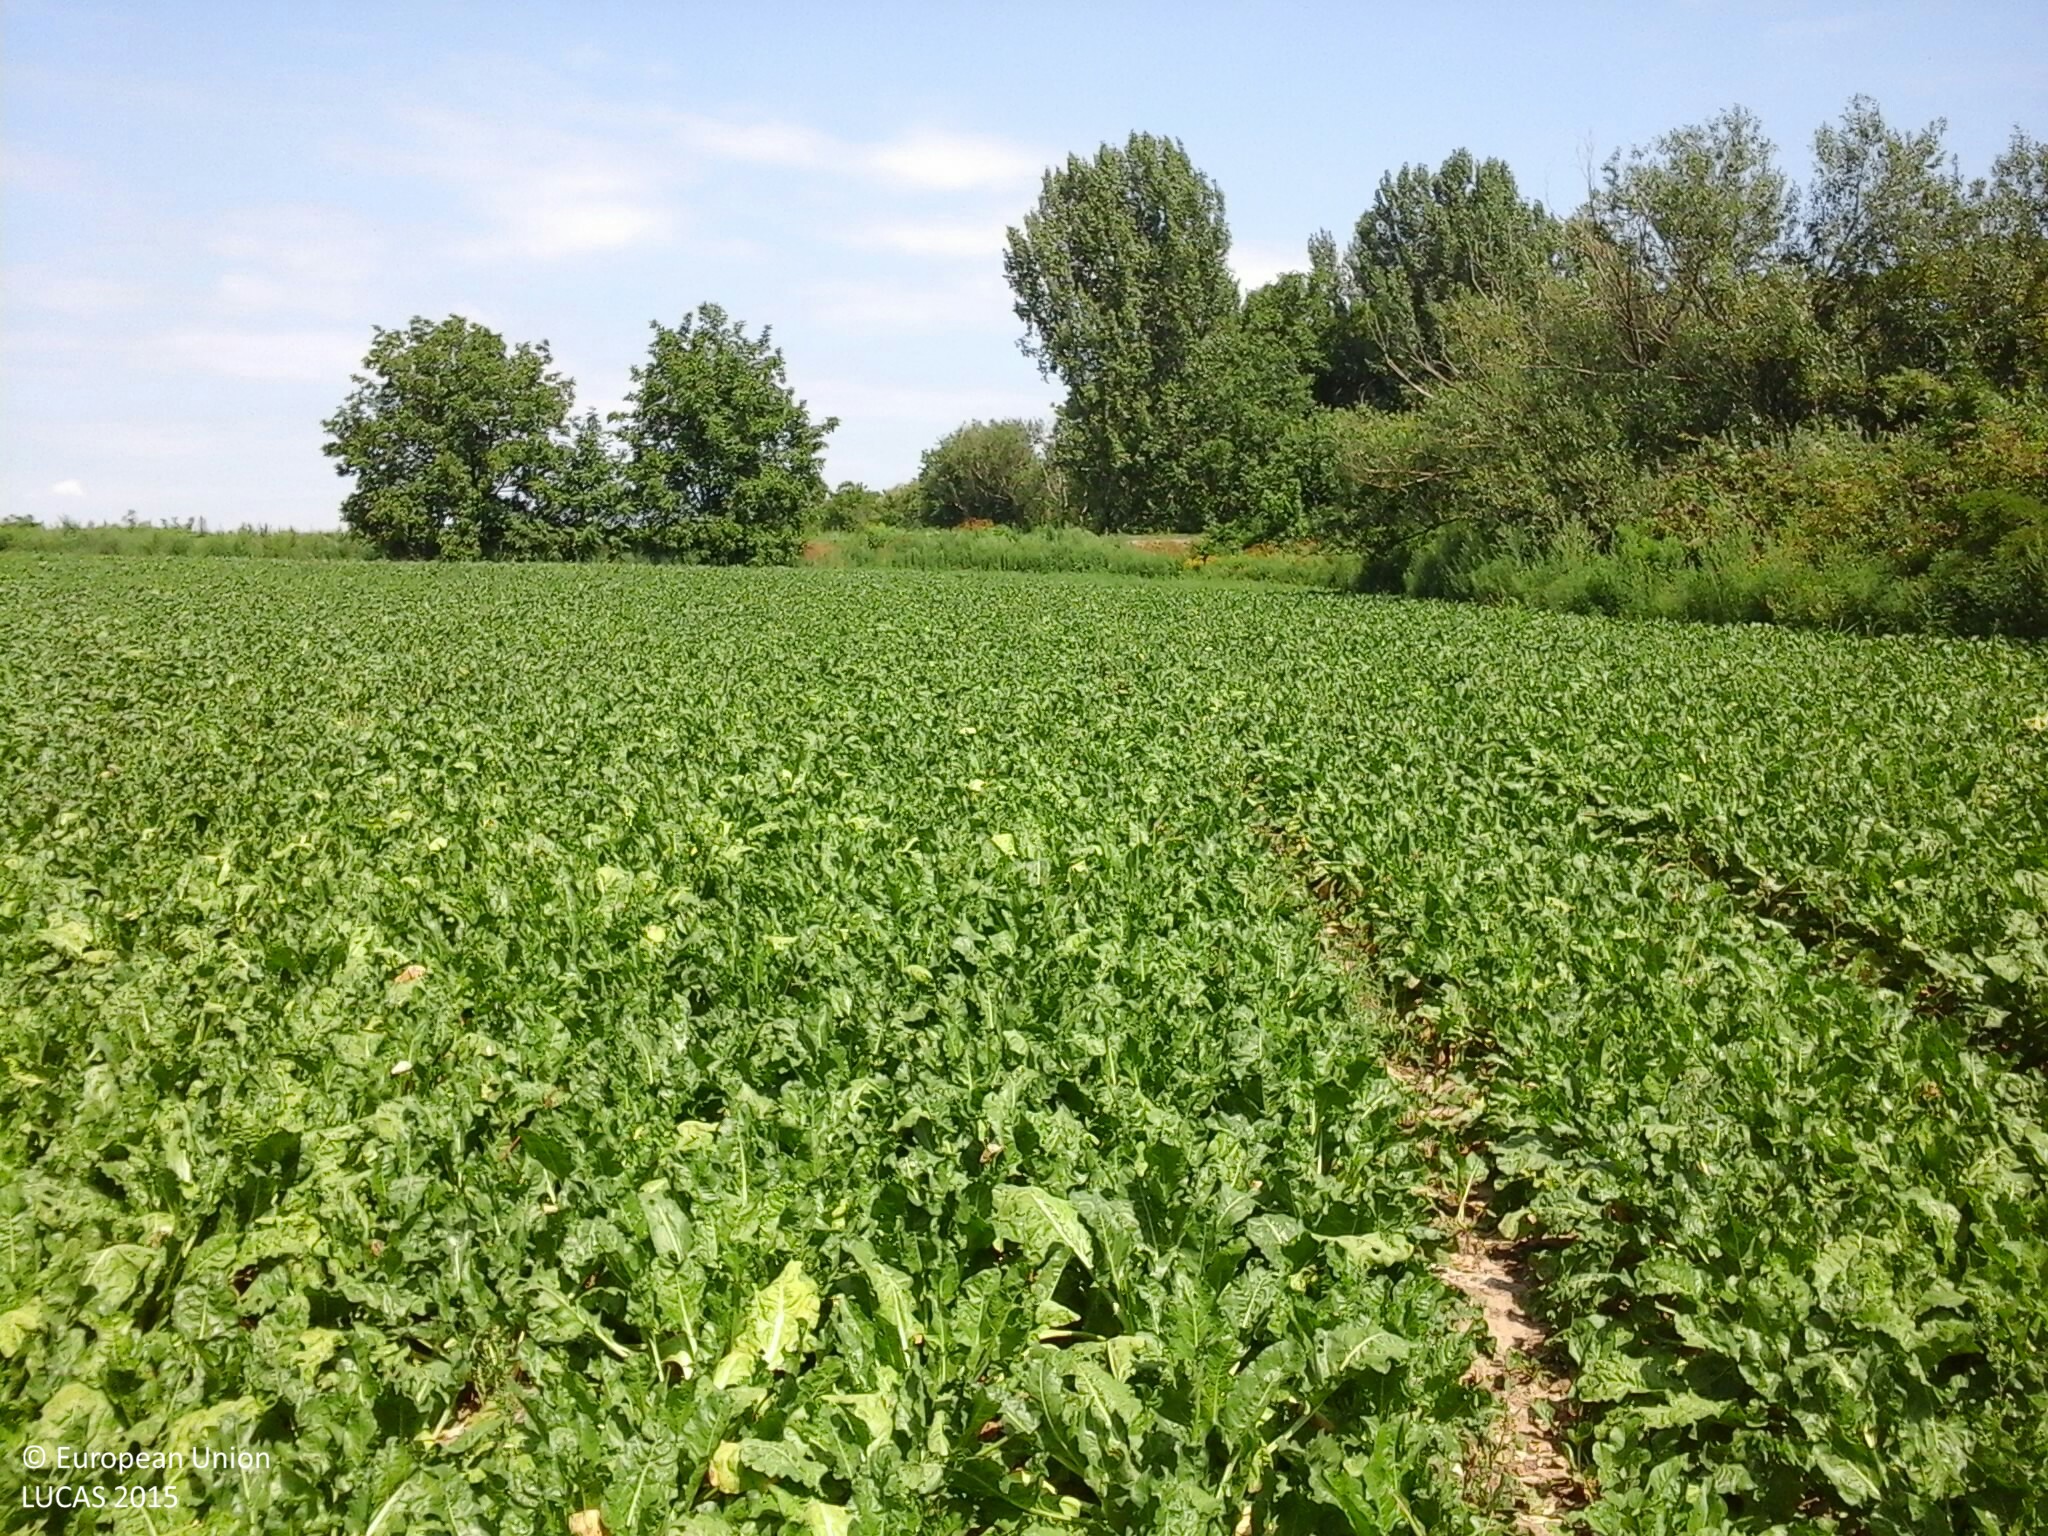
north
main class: Cropland
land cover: Sugar beet
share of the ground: > 75 %
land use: Agriculture (excluding fallow land and kitchen gardens)
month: August
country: HU
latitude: 46.6968
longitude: 18.0773
